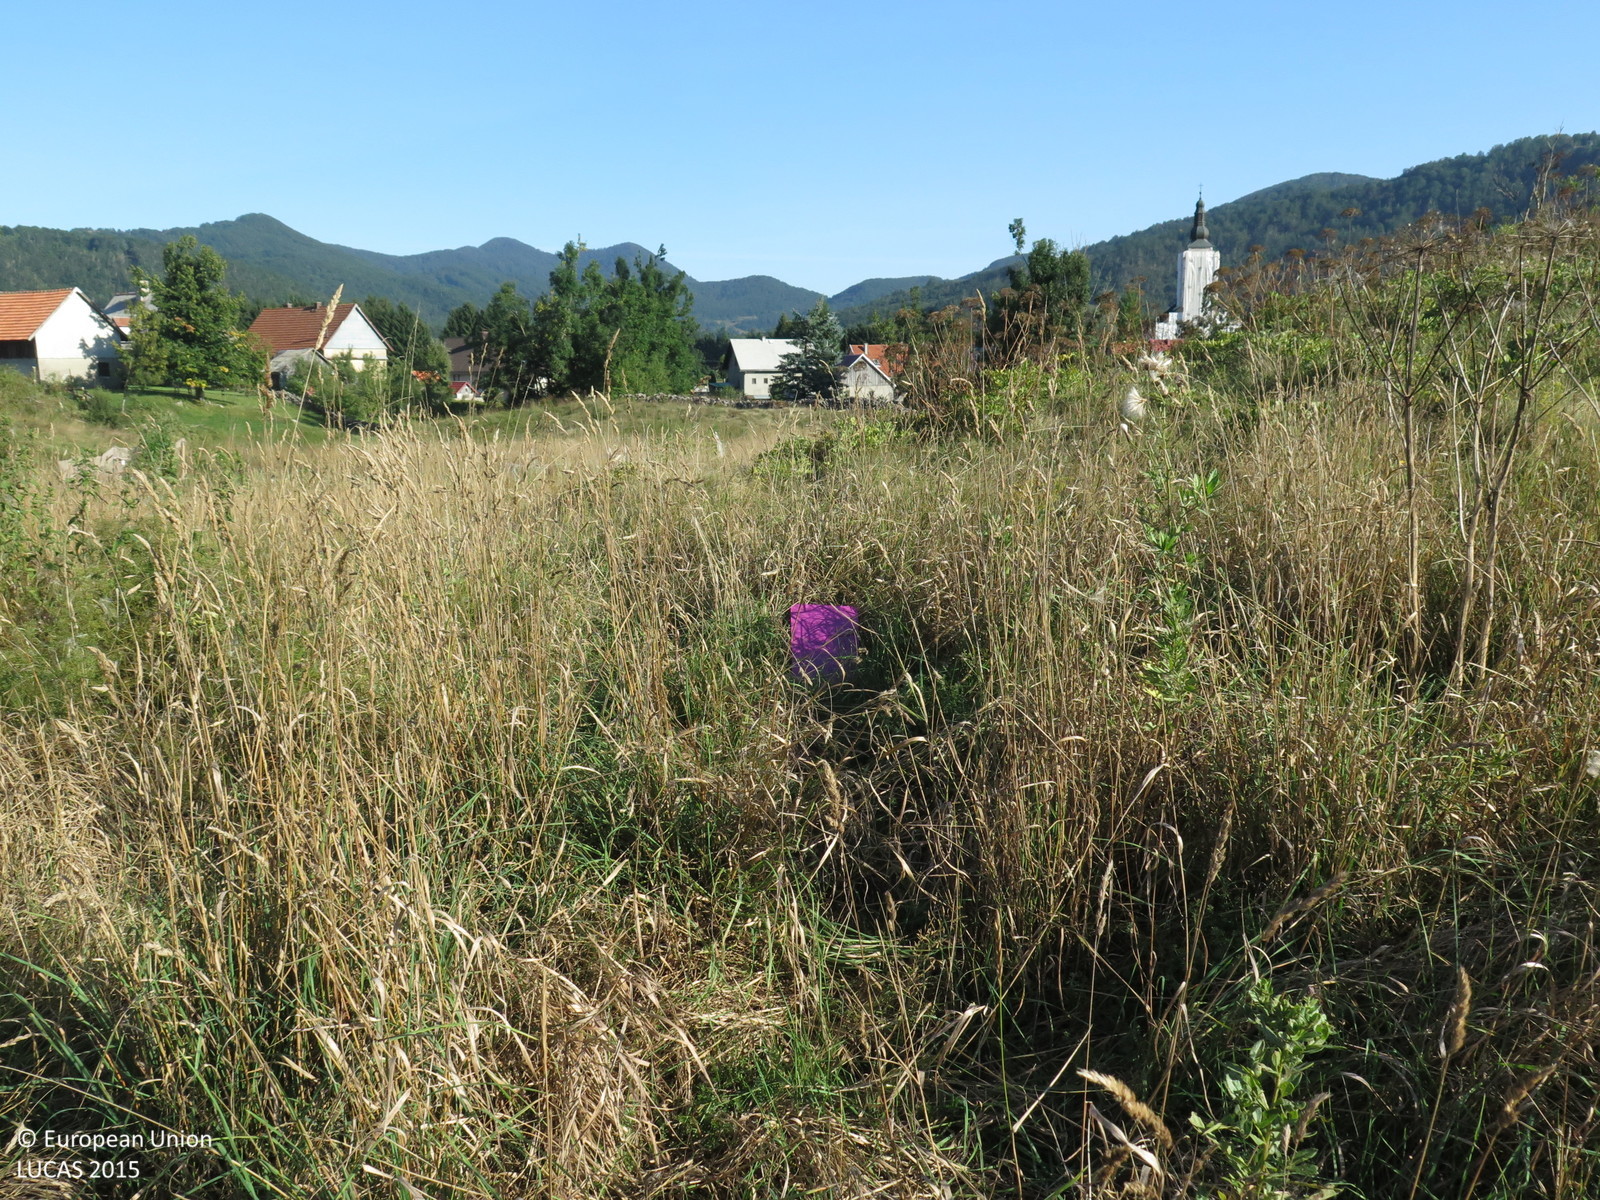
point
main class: Grassland
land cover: Grassland without tree/shrub cover
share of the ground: > 75 %
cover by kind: herbaceous plants 95 %, shrubs 5 %
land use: Agriculture (excluding fallow land and kitchen gardens)
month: August
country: HR
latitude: 45.3205
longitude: 14.8556
